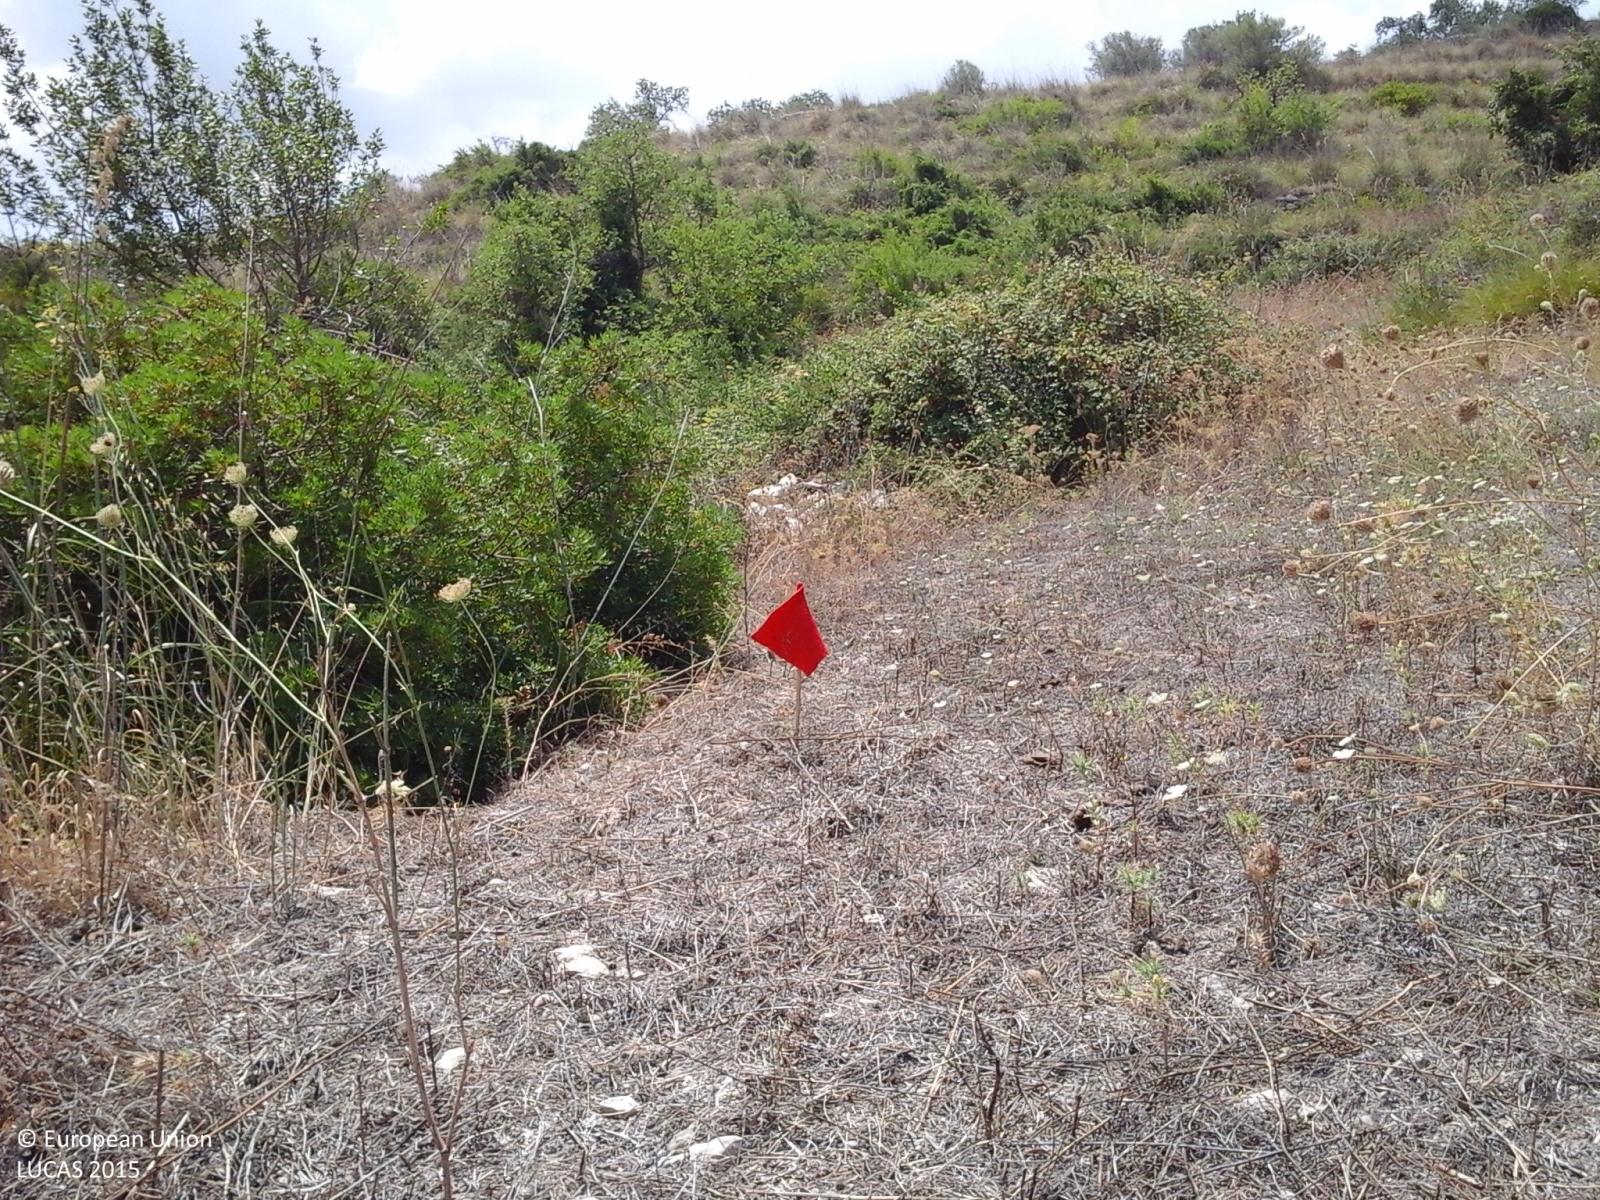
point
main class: Shrubland
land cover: Shrubland with sparse tree cover
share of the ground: > 75 %
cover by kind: herbaceous plants 55 %, shrubs 40 %, coniferous forest trees 5 %
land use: Agriculture (excluding fallow land and kitchen gardens)
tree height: < 5 m
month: August
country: IT
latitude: 36.9498
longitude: 14.8691
